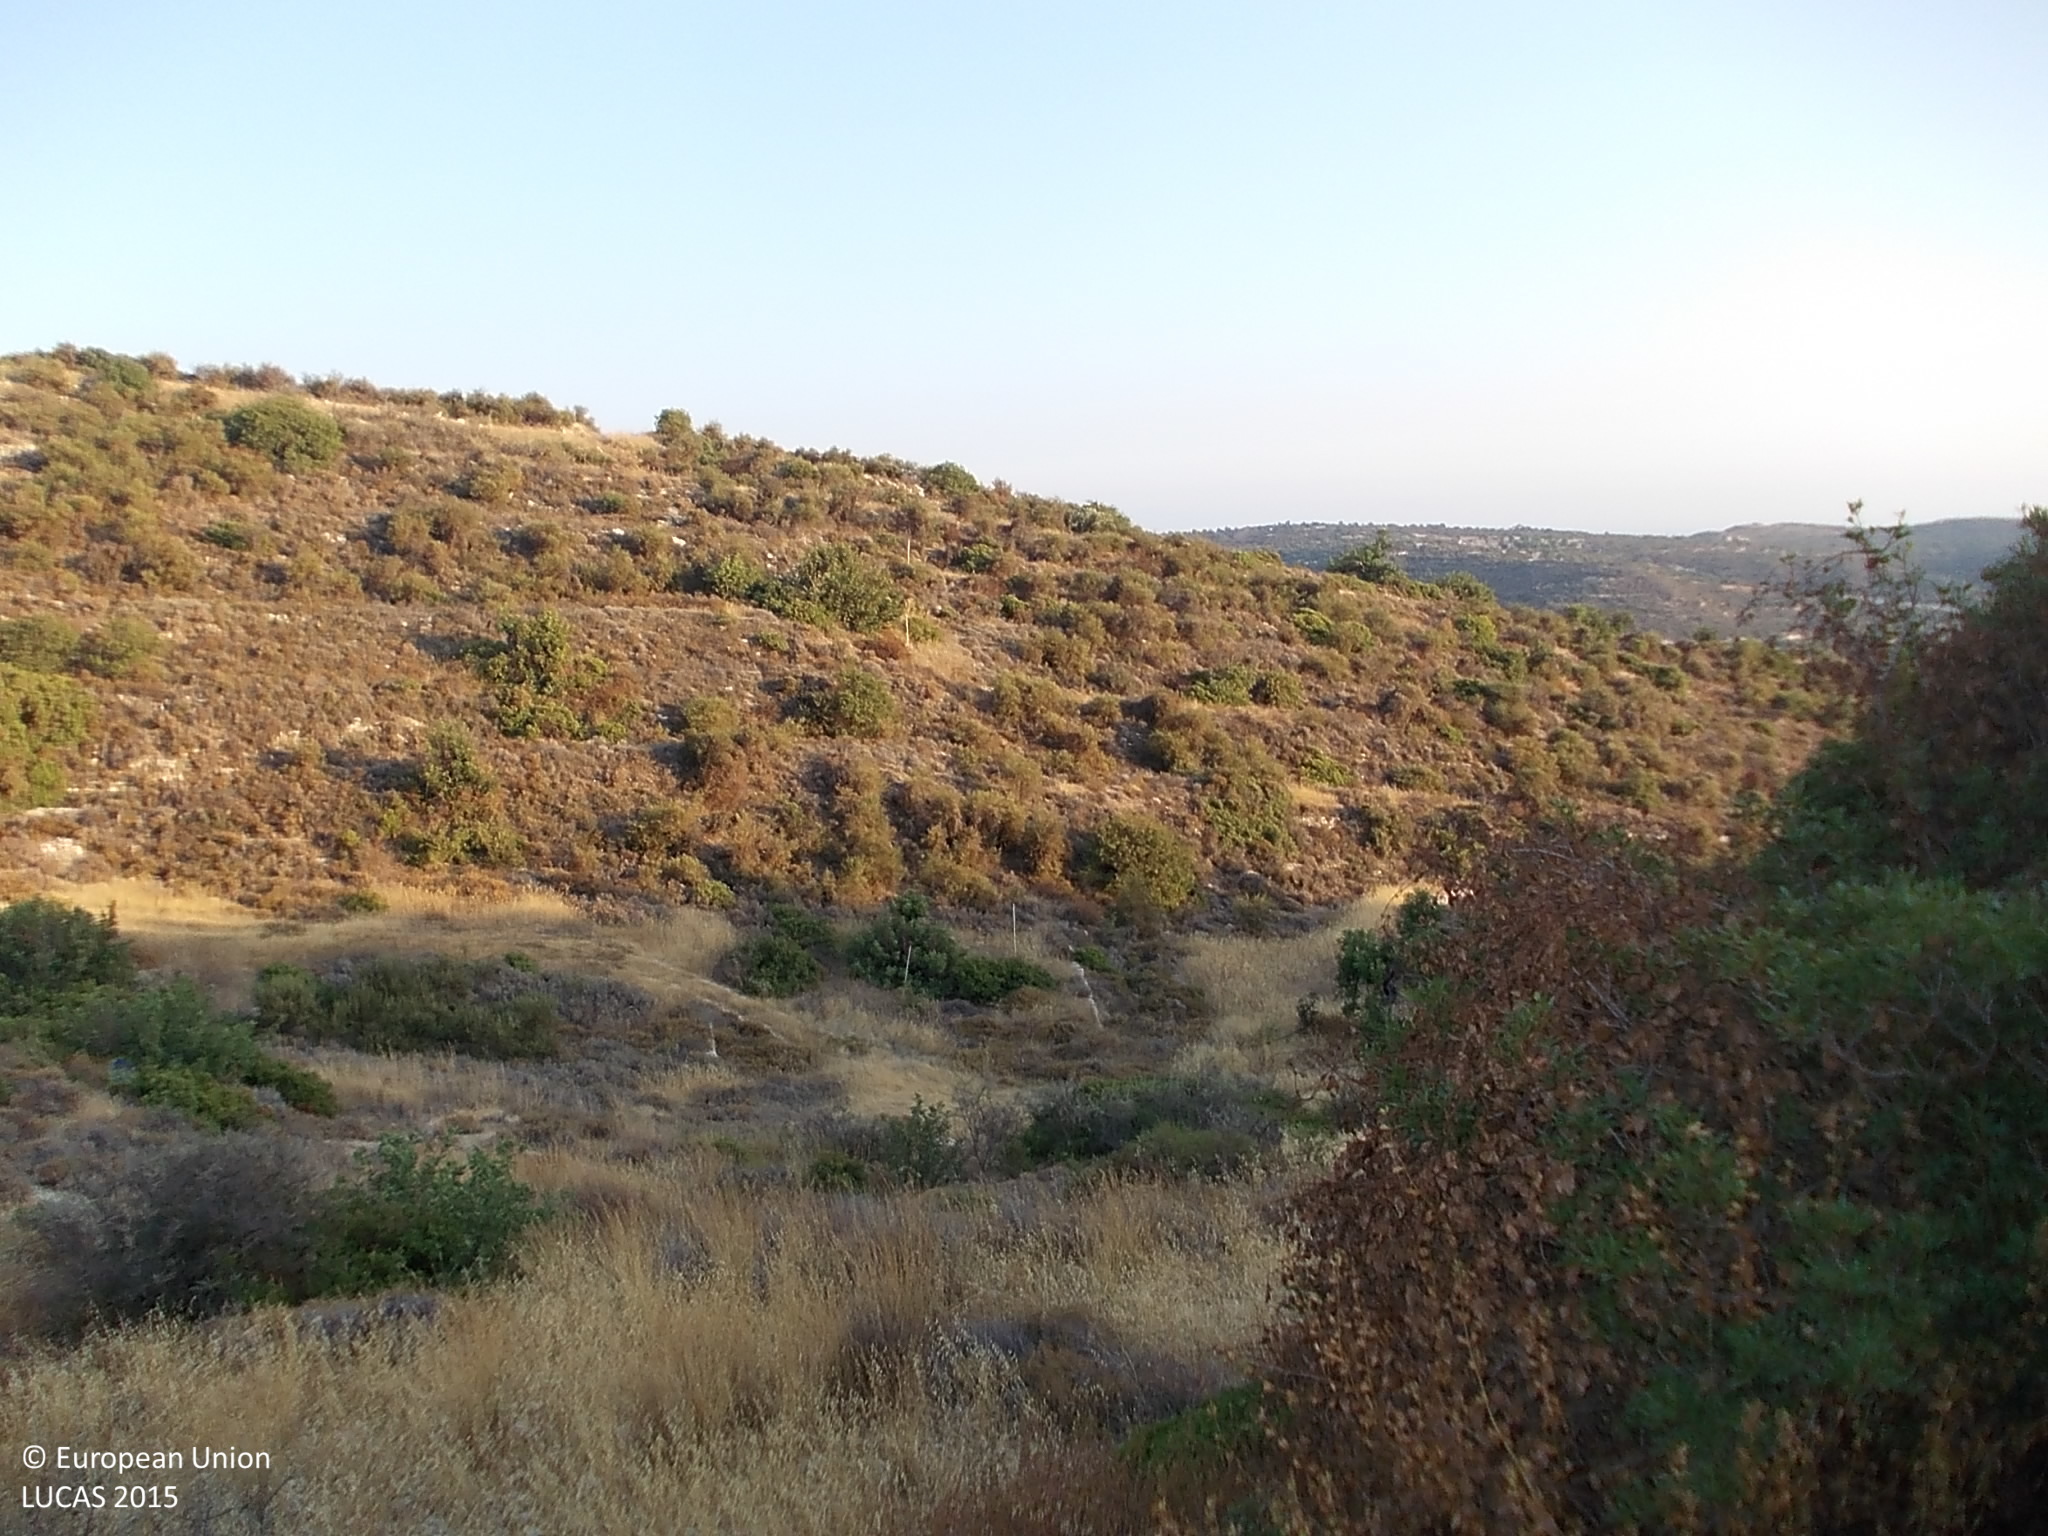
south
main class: Shrubland
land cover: Shrubland with sparse tree cover
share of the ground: > 75 %
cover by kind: shrubs 75 %, herbaceous plants 15 %, broadleaved forest trees 5 %, consolidated bare surface 5 %
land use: Semi-natural and natural areas not in use
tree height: < 5 m
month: August
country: CY
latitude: 34.7716
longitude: 33.0140
